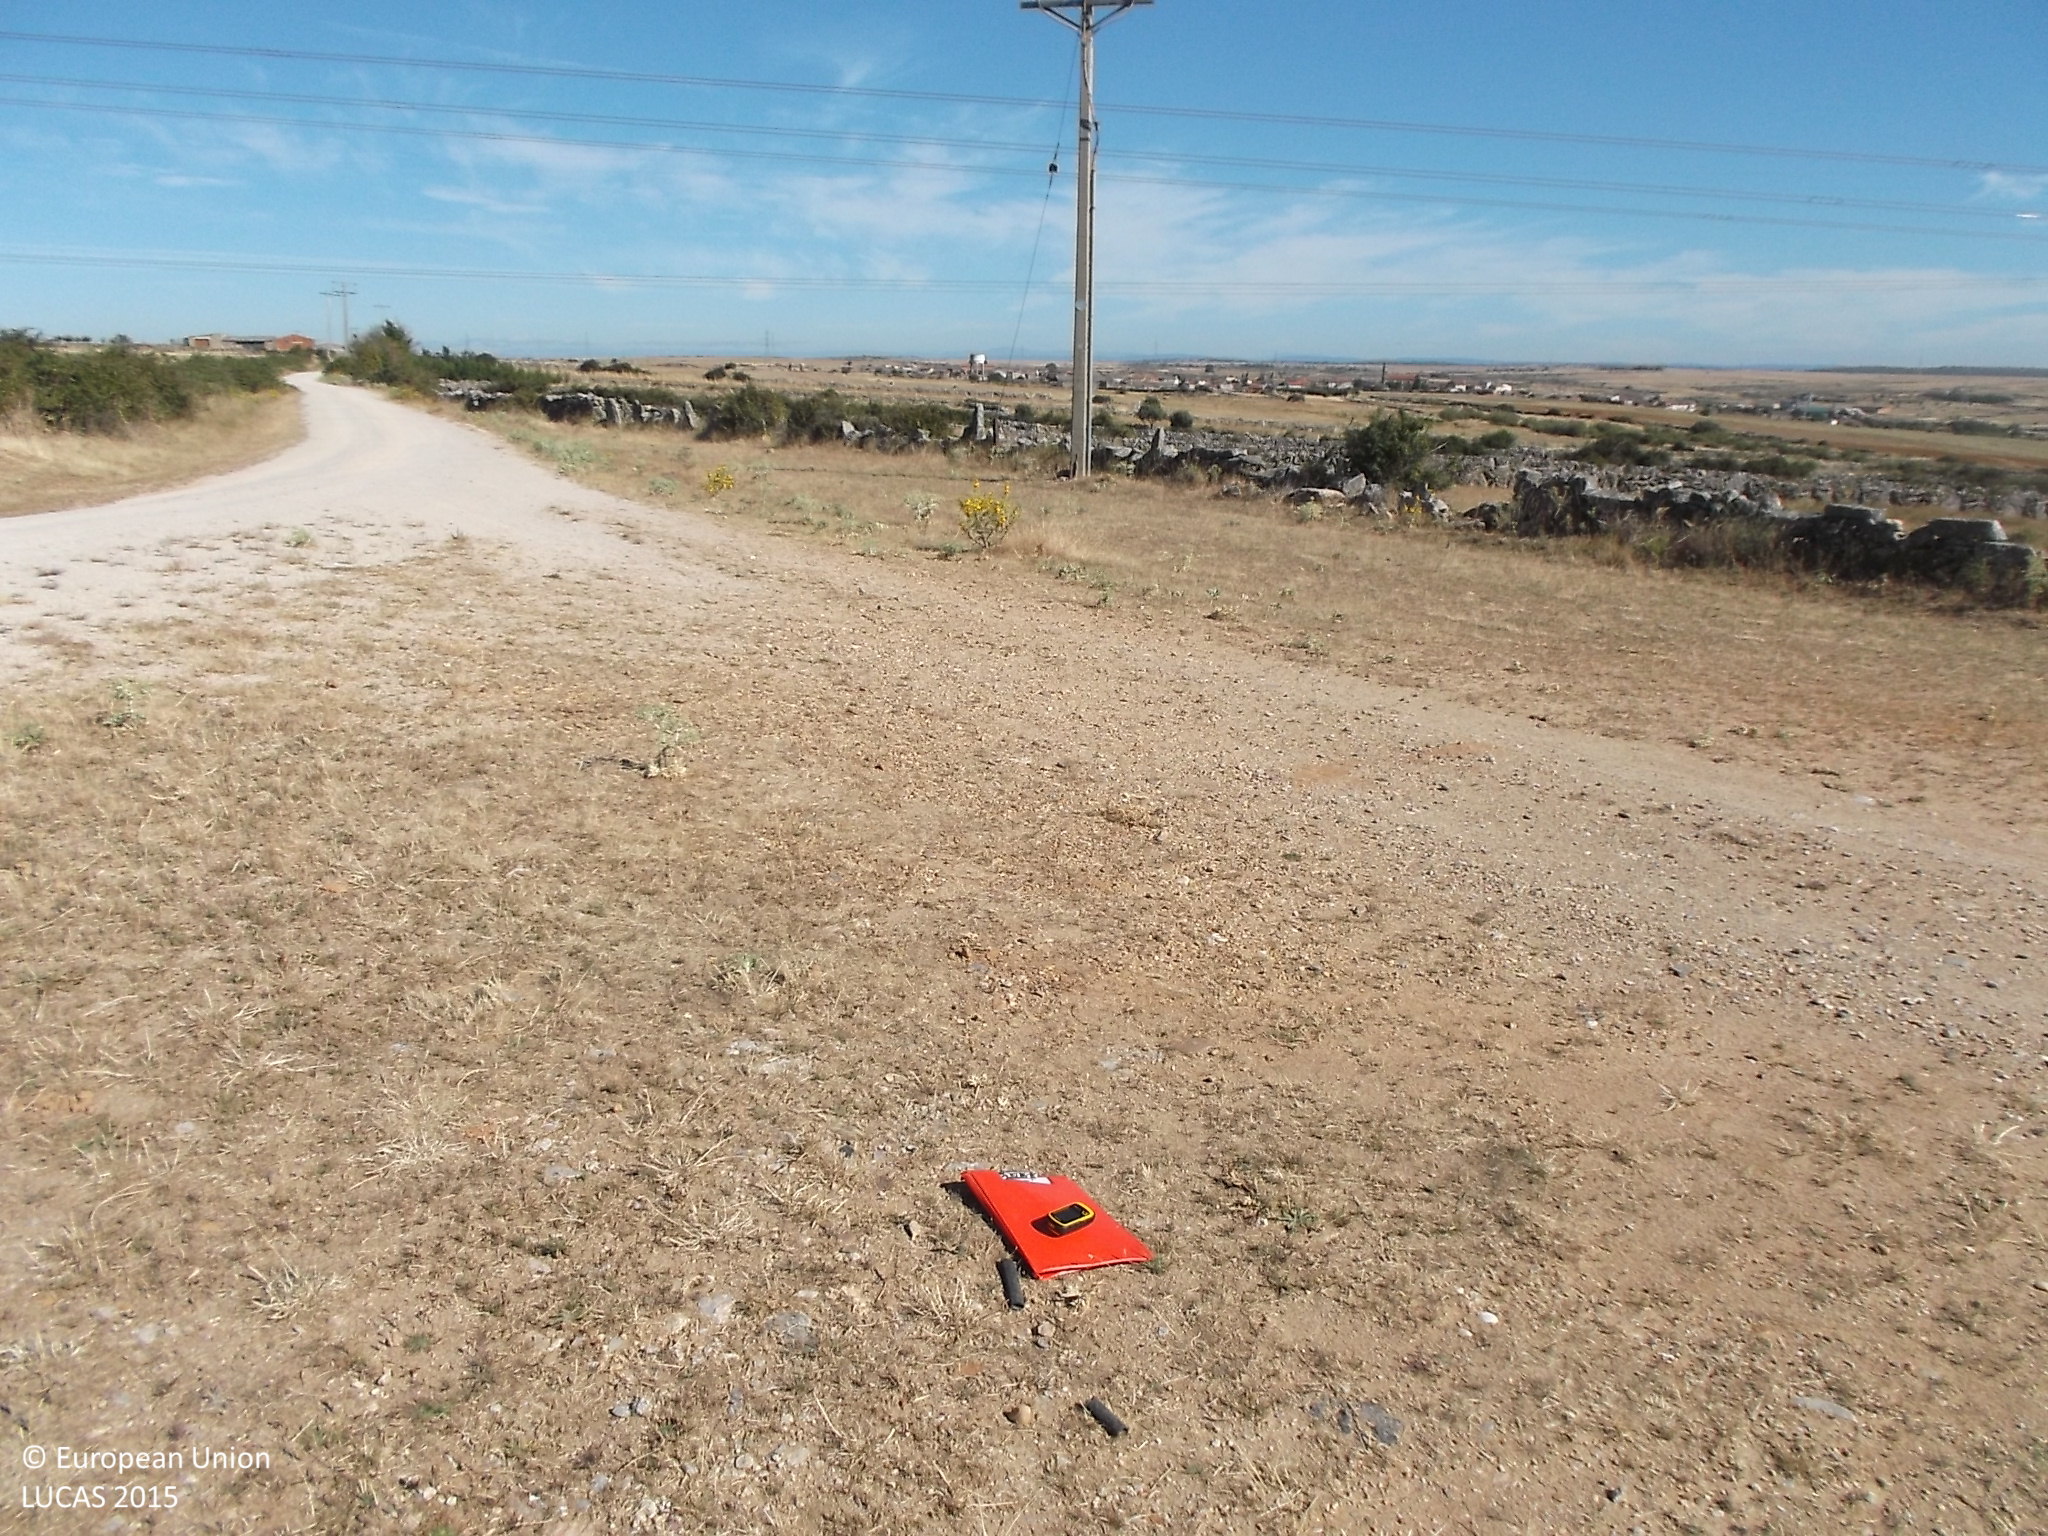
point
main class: Grassland
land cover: Grassland without tree/shrub cover
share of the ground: > 75 %
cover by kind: herbaceous plants 100 %
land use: Agriculture (excluding fallow land and kitchen gardens)
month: July
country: ES
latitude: 41.5129
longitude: -6.0406
